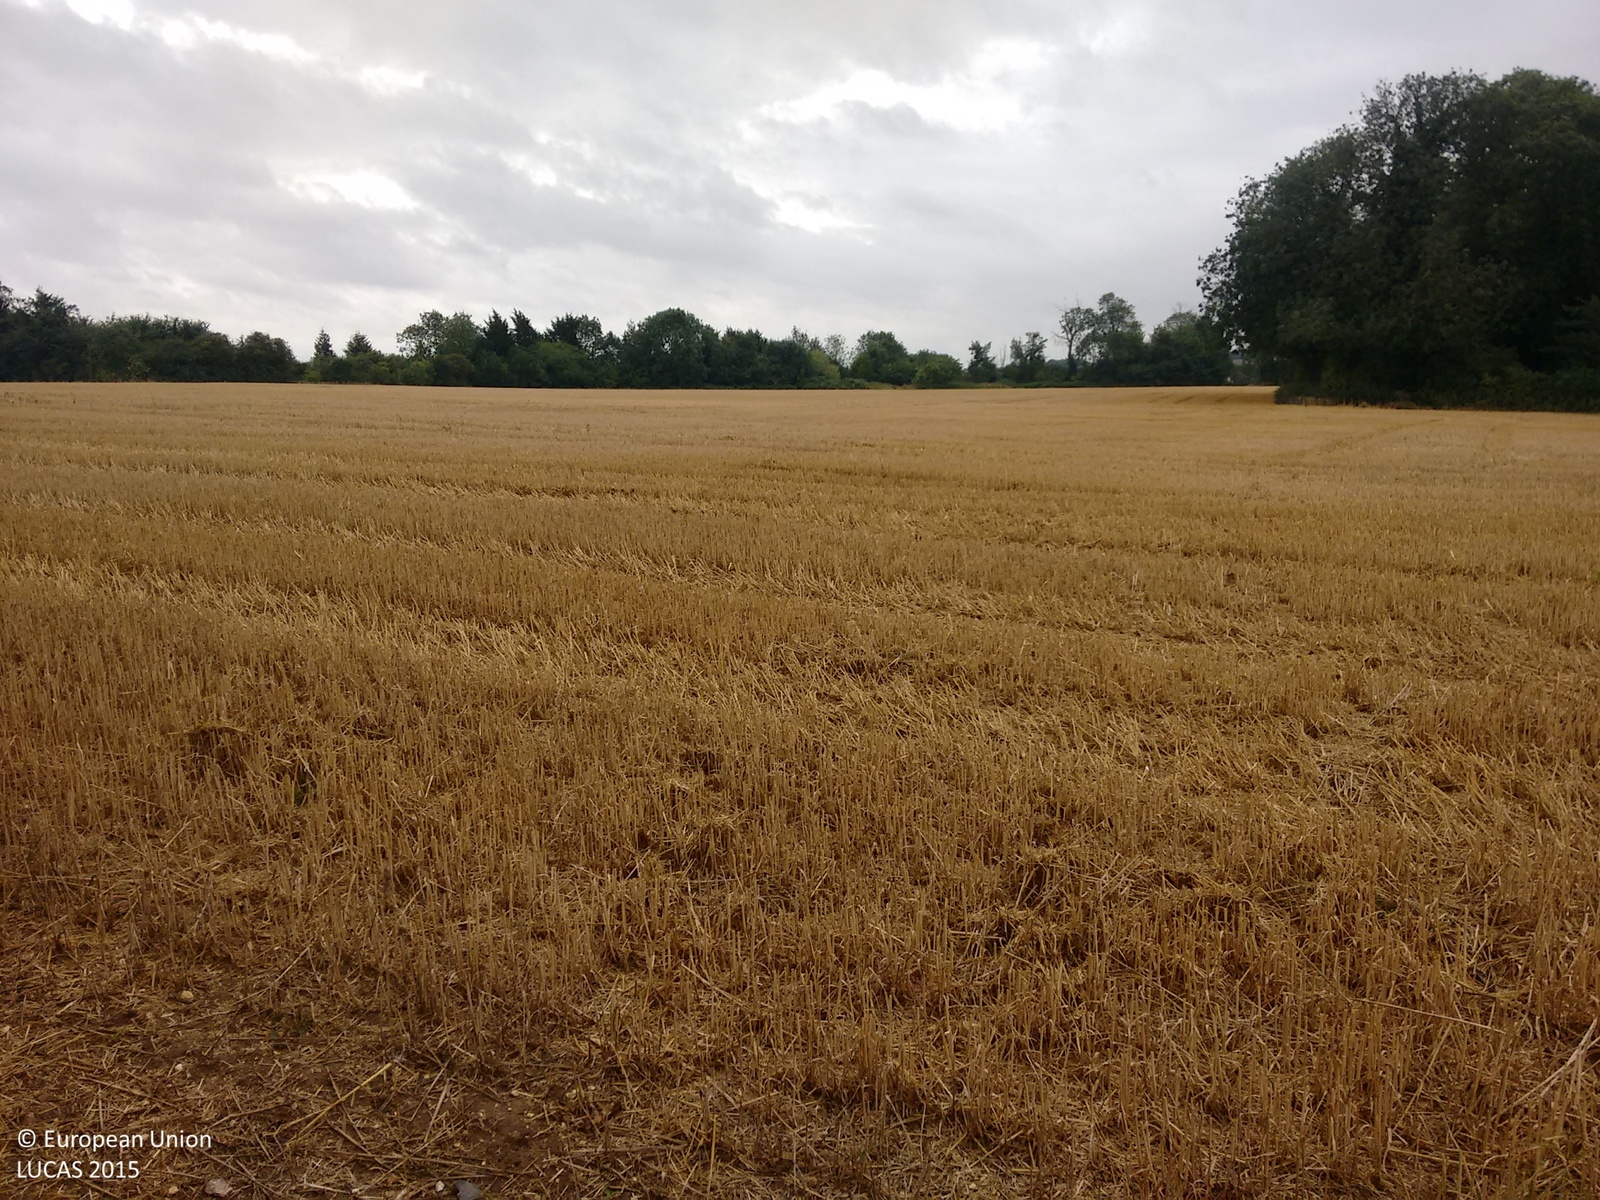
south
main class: Woodland
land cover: Other mixed woodland
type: mesophytic deciduous forest
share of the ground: > 75 %
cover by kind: broadleaved forest trees 70 %, coniferous forest trees 25 %, shrubs 5 %
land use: Semi-natural and natural areas not in use
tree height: > 5 m
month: August
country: GB
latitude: 52.1242
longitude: 0.5222
